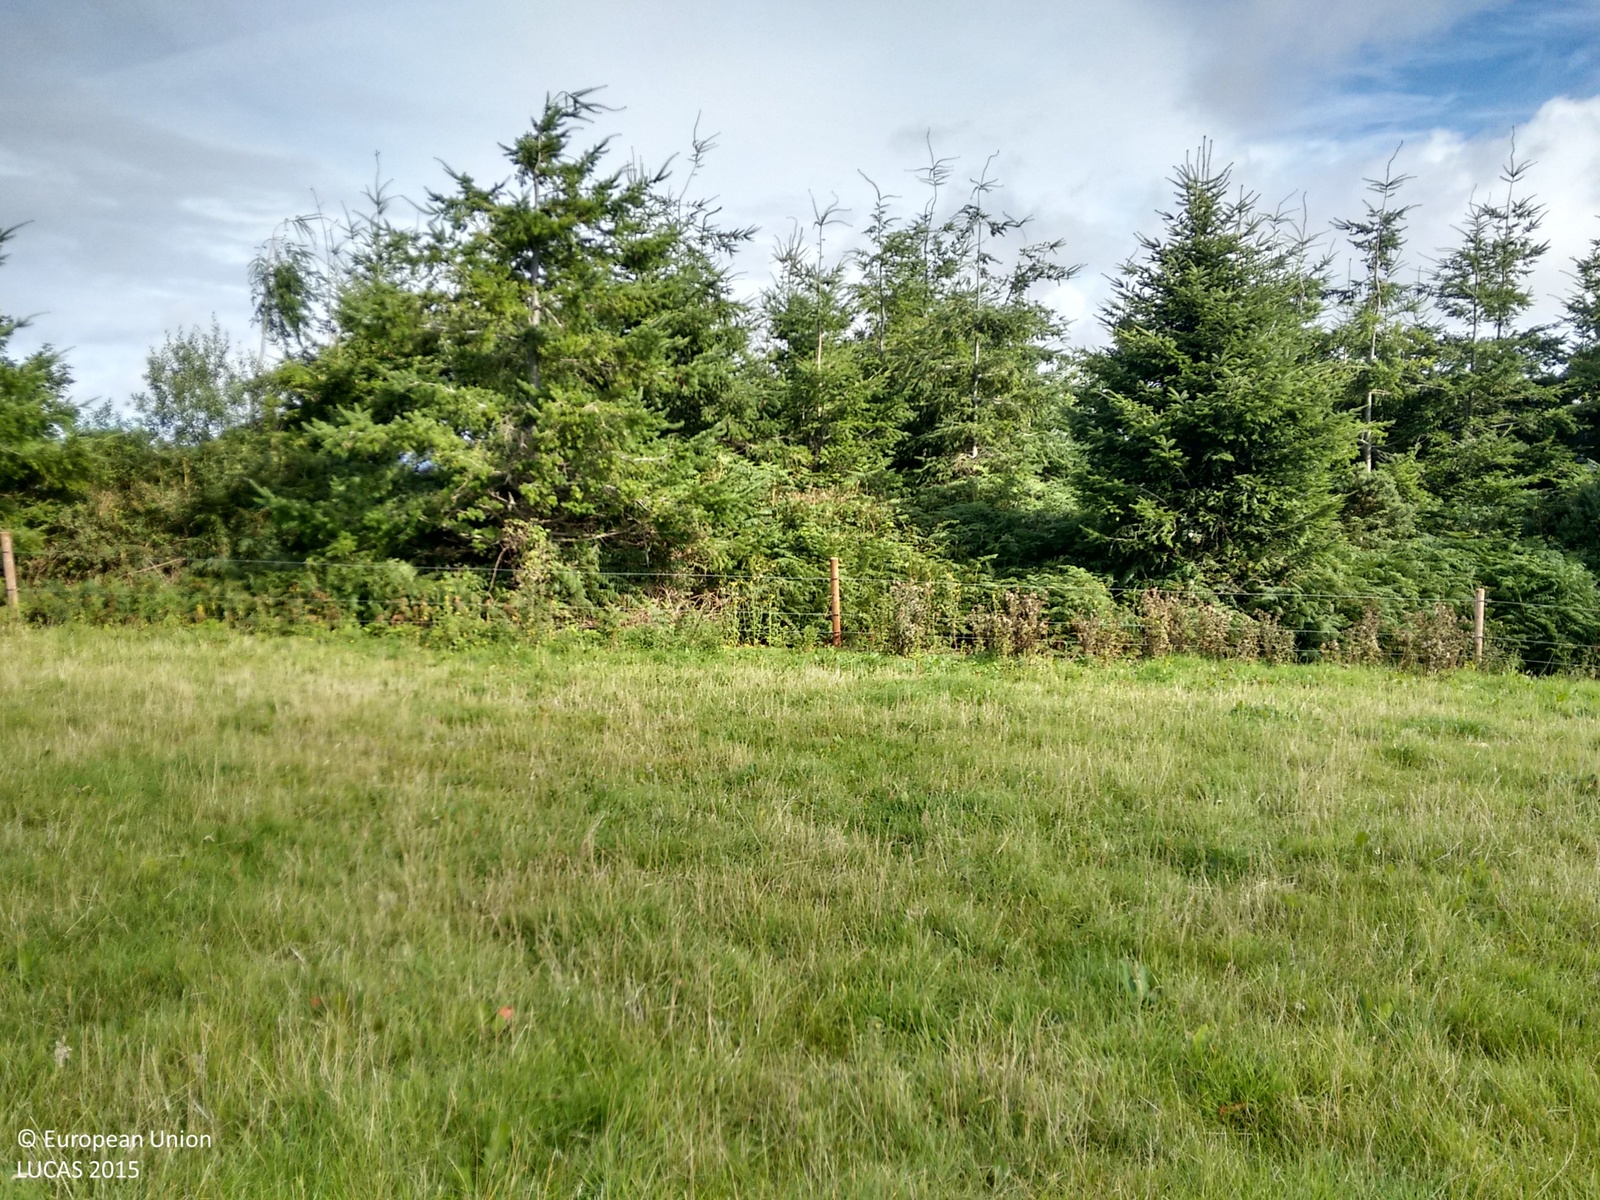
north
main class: Grassland
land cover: Grassland without tree/shrub cover
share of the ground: > 75 %
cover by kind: herbaceous plants 100 %
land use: Agriculture (excluding fallow land and kitchen gardens)
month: August
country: IE
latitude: 52.4216
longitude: -6.6454
